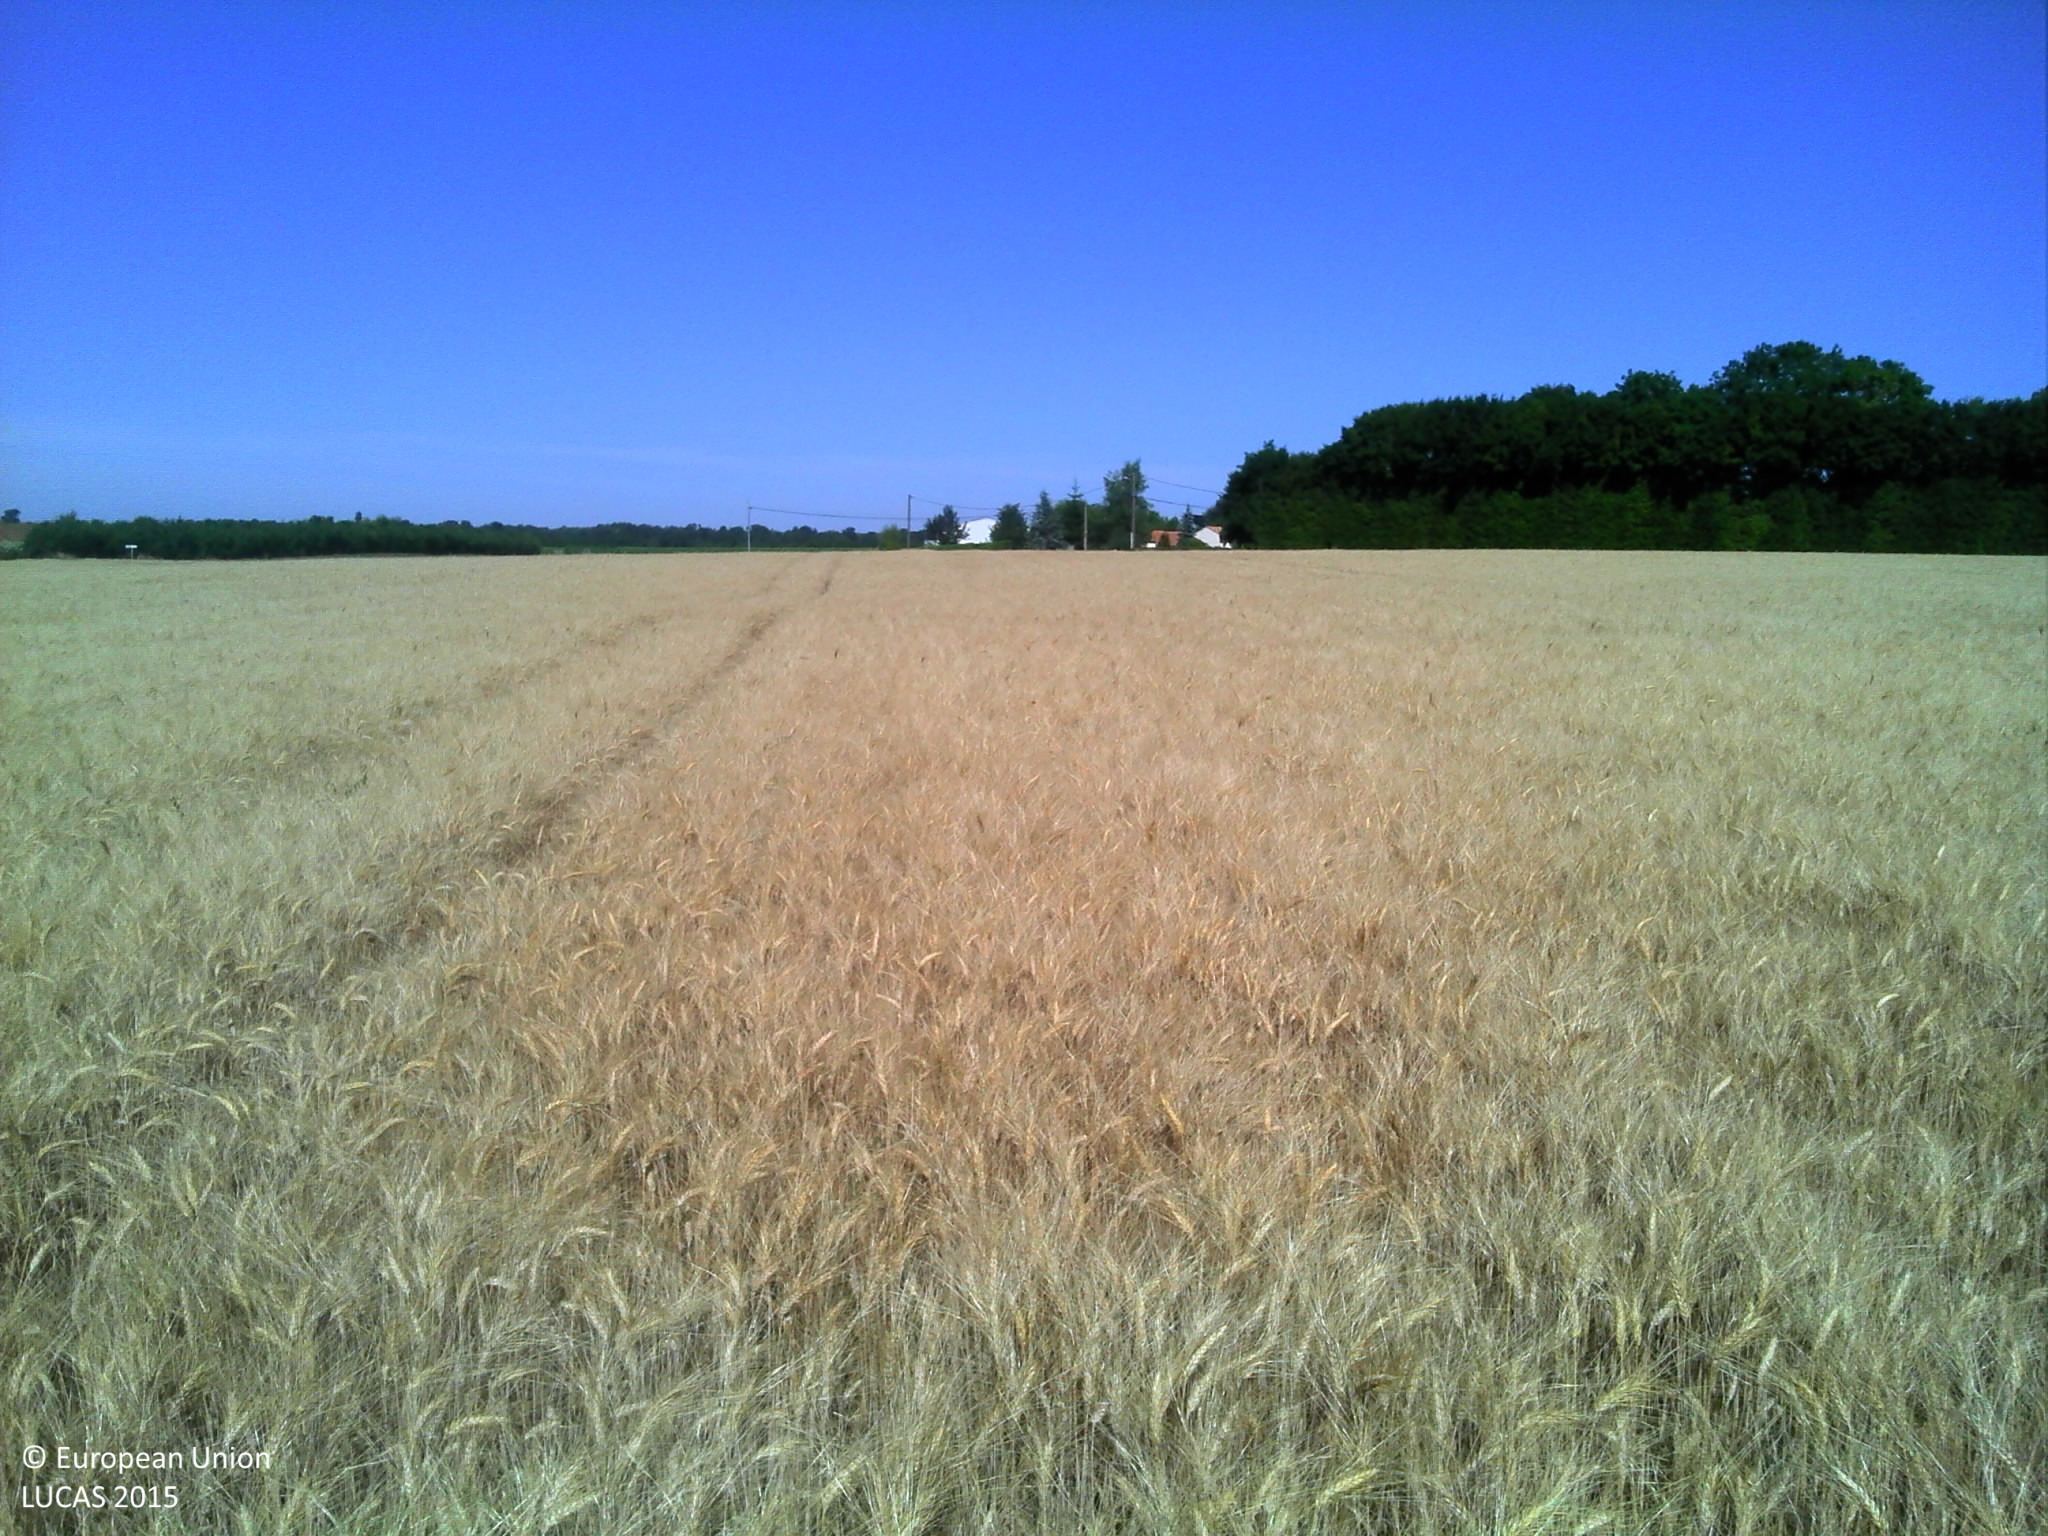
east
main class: Cropland
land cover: Durum wheat
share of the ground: > 75 %
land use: Agriculture (excluding fallow land and kitchen gardens)
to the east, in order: Durum wheat; Artificial constructions in urban areas
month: June
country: FR
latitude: 45.5795
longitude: -0.6735
